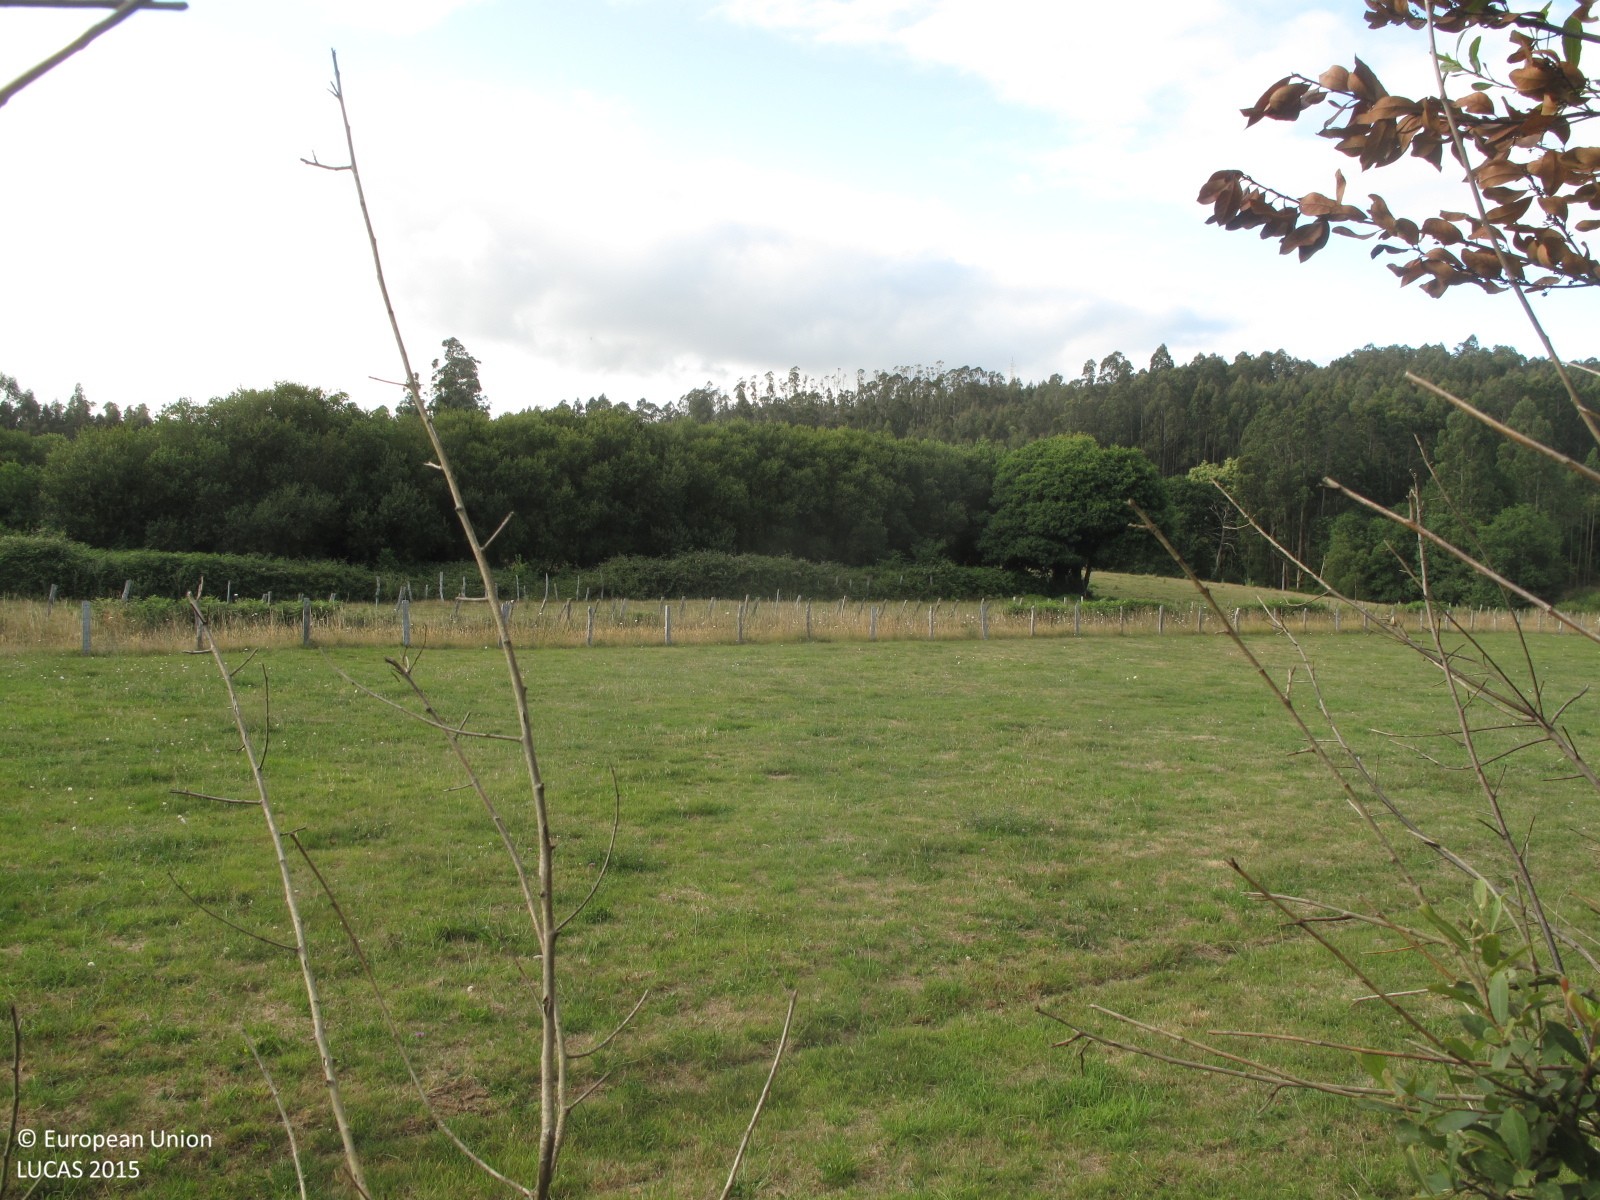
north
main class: Woodland
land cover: Pine dominated mixed woodland
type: exotic forest
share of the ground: 50 - 75 %
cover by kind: coniferous forest trees 40 %, shrubs 40 %, broadleaved forest trees 20 %
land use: Forestry
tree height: > 5 m
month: July
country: ES
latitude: 43.5697
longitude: -8.0137
